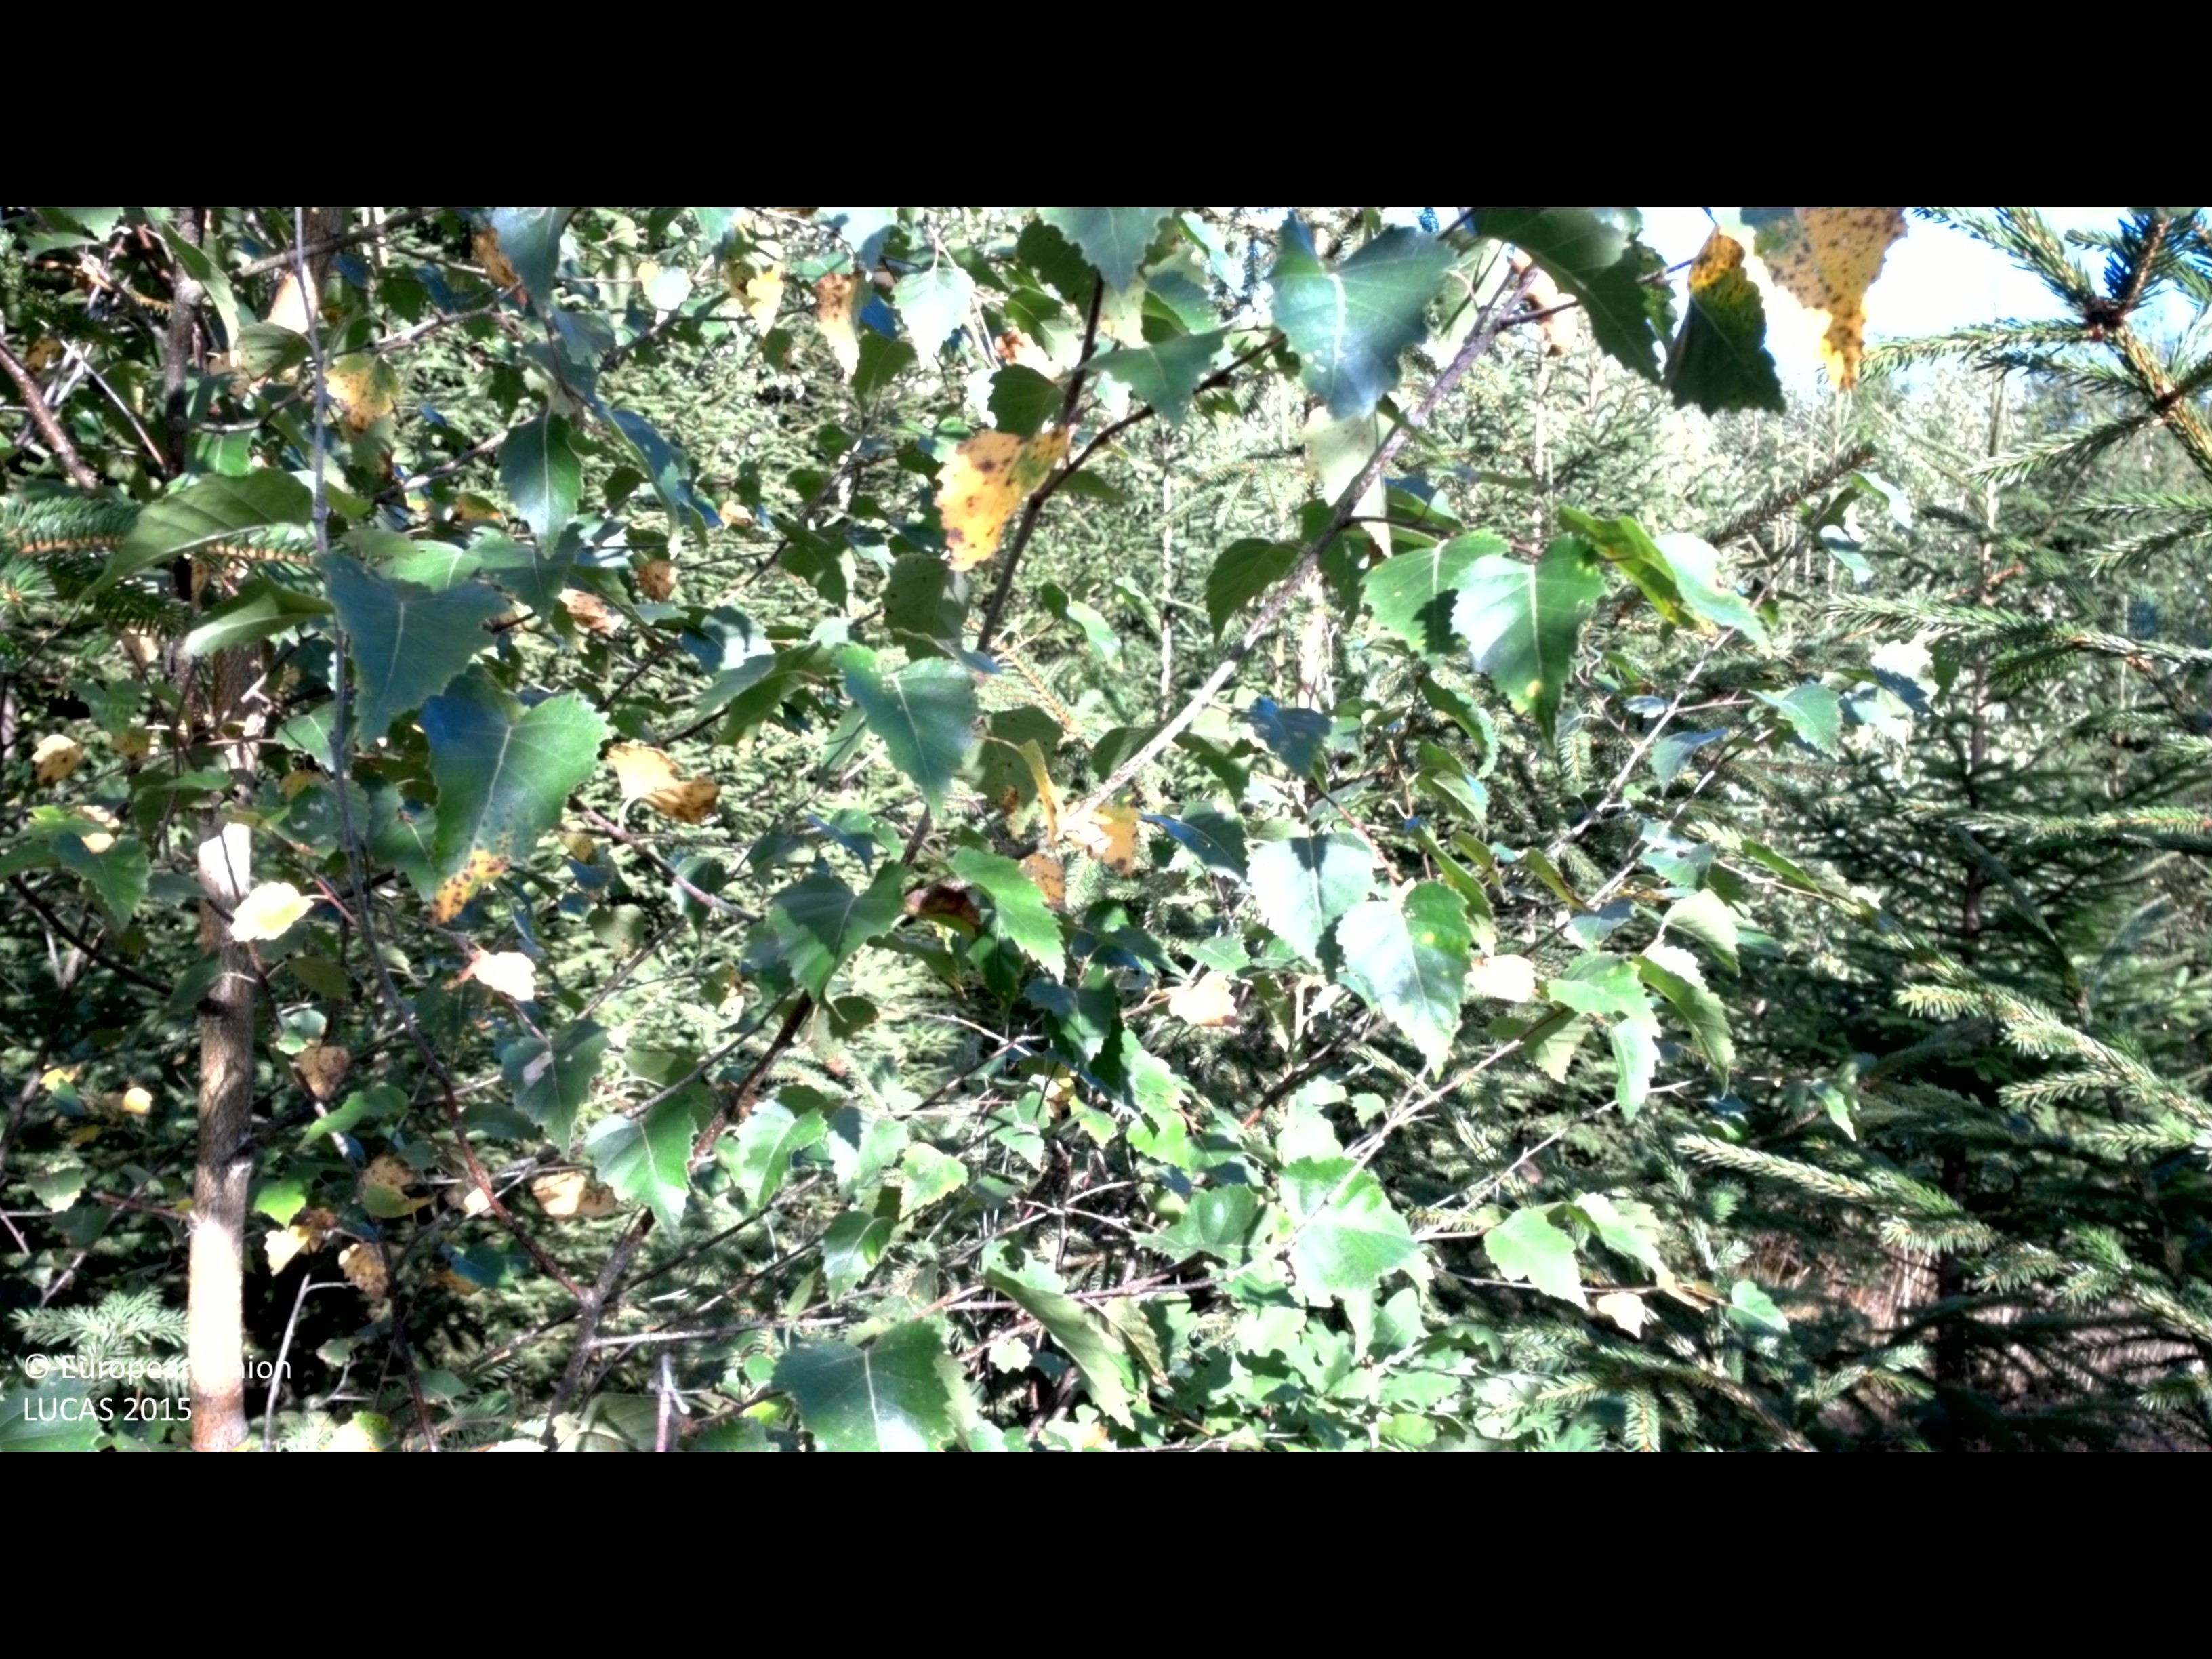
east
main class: Woodland
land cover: Spruce dominated mixed woodland
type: boreal forest
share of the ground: 50 - 75 %
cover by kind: broadleaved forest trees 40 %, herbaceous plants 30 %, coniferous forest trees 20 %, shrubs 10 %
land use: Forestry
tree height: < 5 m
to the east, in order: Spruce dominated mixed woodland; Spruce dominated coniferous woodland; Ditches and canals; Spruce dominated coniferous woodland; Paved roads, cycling and walking lanes; Electric lines; Spruce dominated coniferous woodland; Spruce dominated mixed woodland
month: August
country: SE
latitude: 57.0654
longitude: 13.8718
